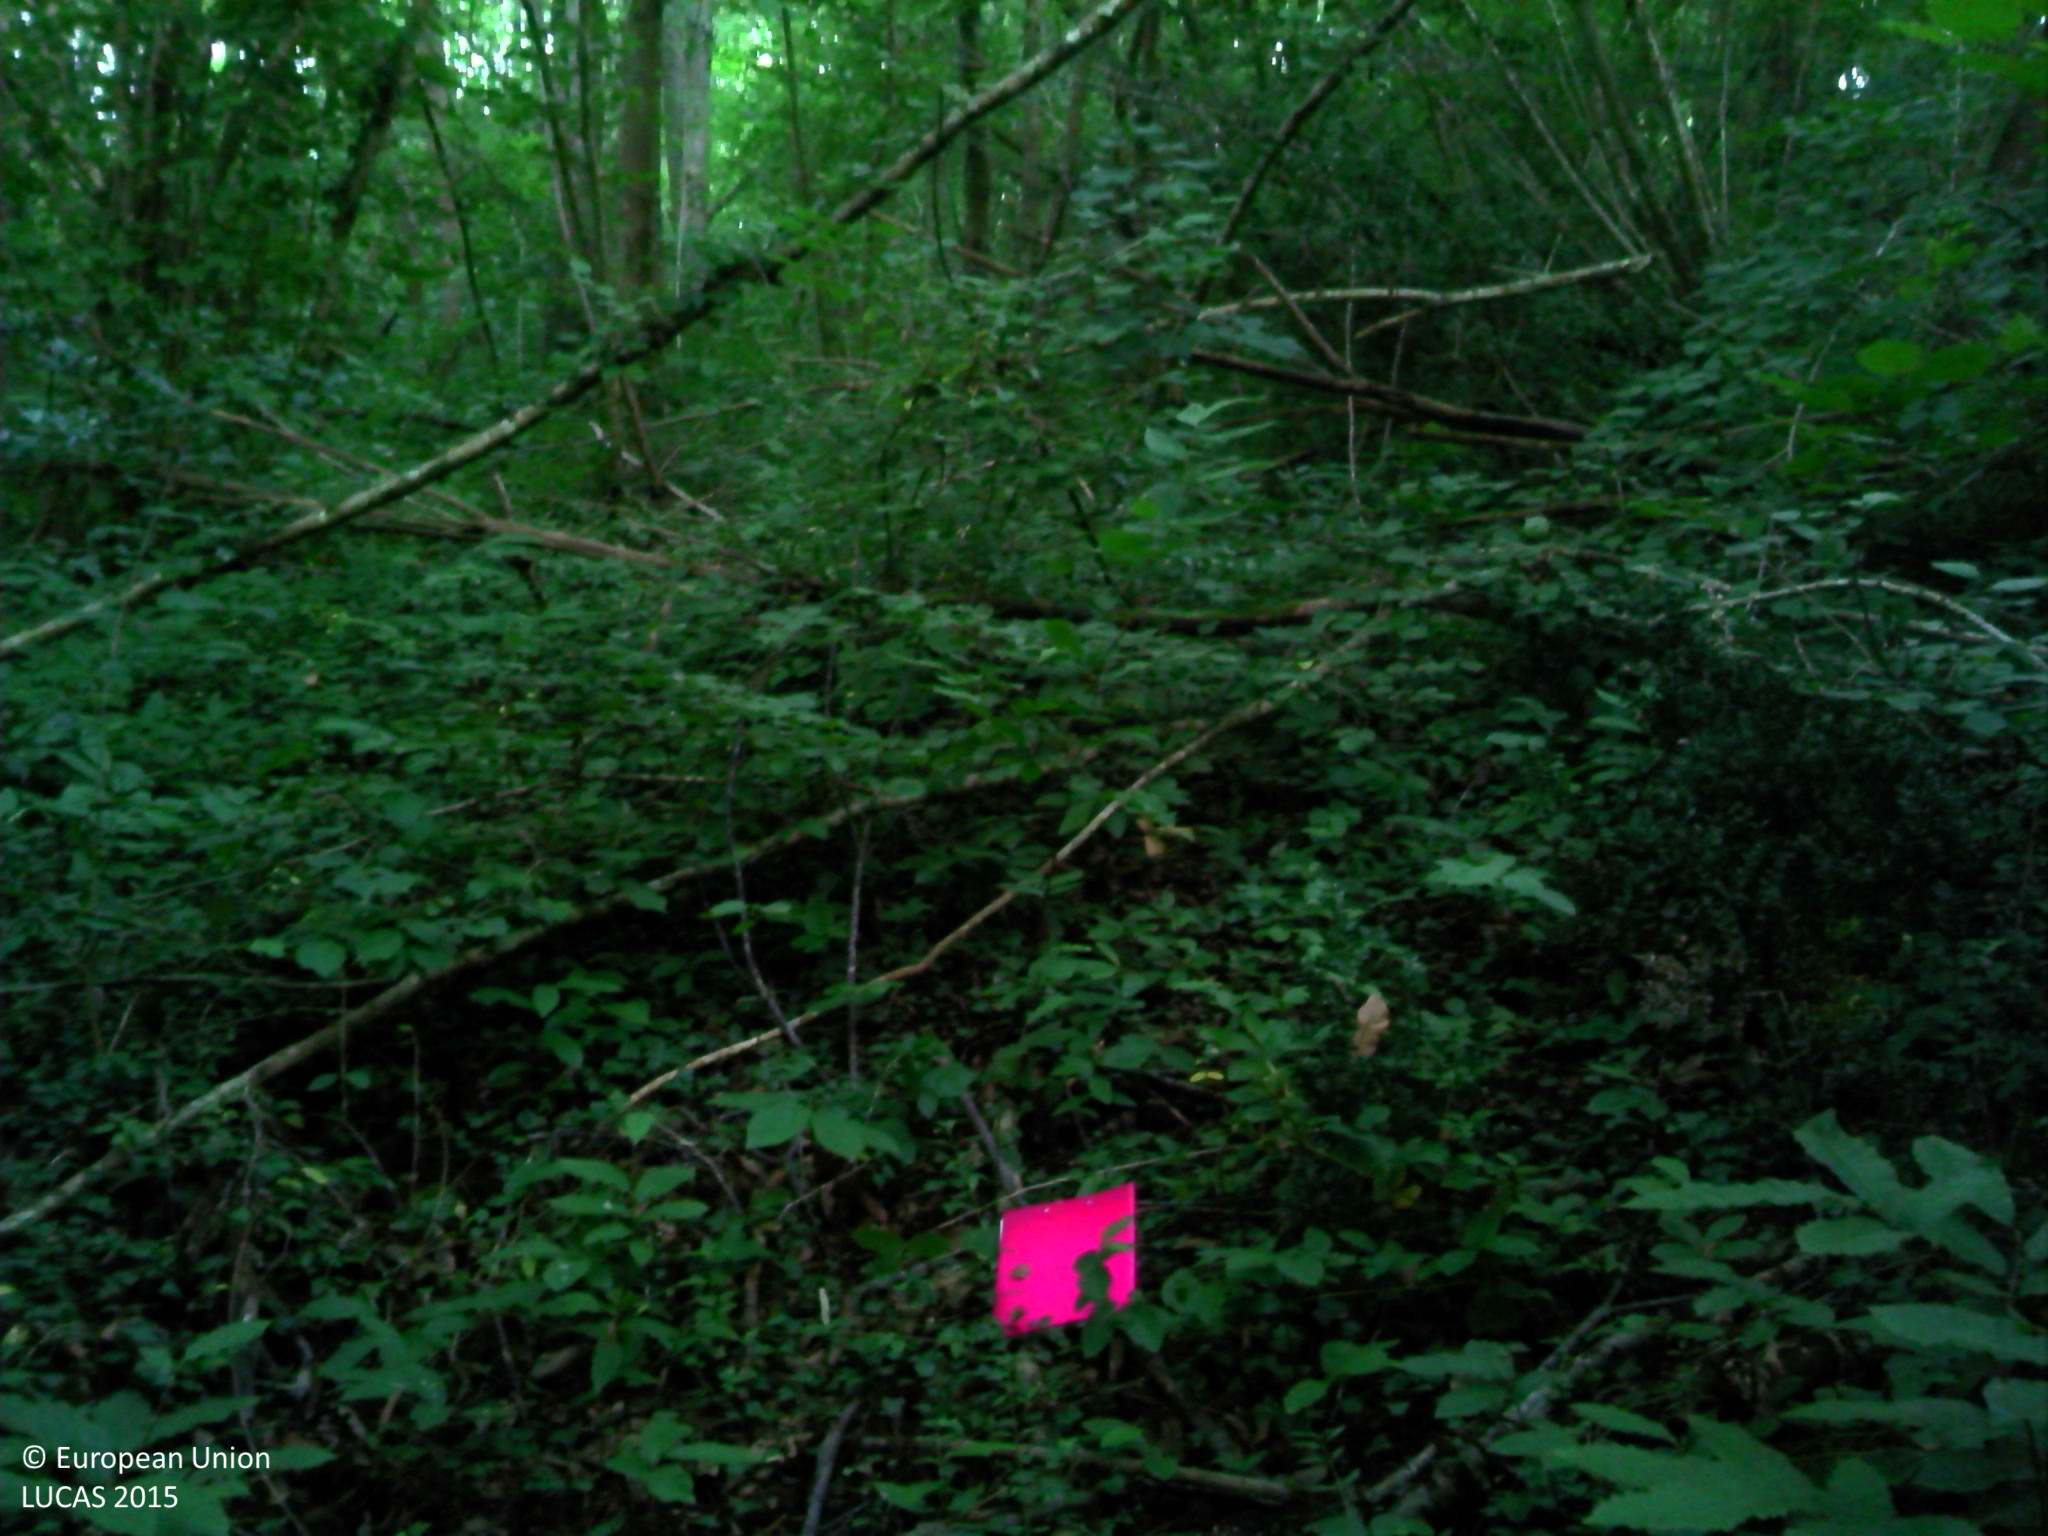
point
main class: Woodland
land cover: Broadleaved woodland
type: thermophilous deciduous forest
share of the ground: > 75 %
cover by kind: broadleaved forest trees 90 %, shrubs 5 %, herbaceous plants 5 %
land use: Forestry
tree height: > 5 m
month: August
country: FR
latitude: 43.3576
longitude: -1.0561
